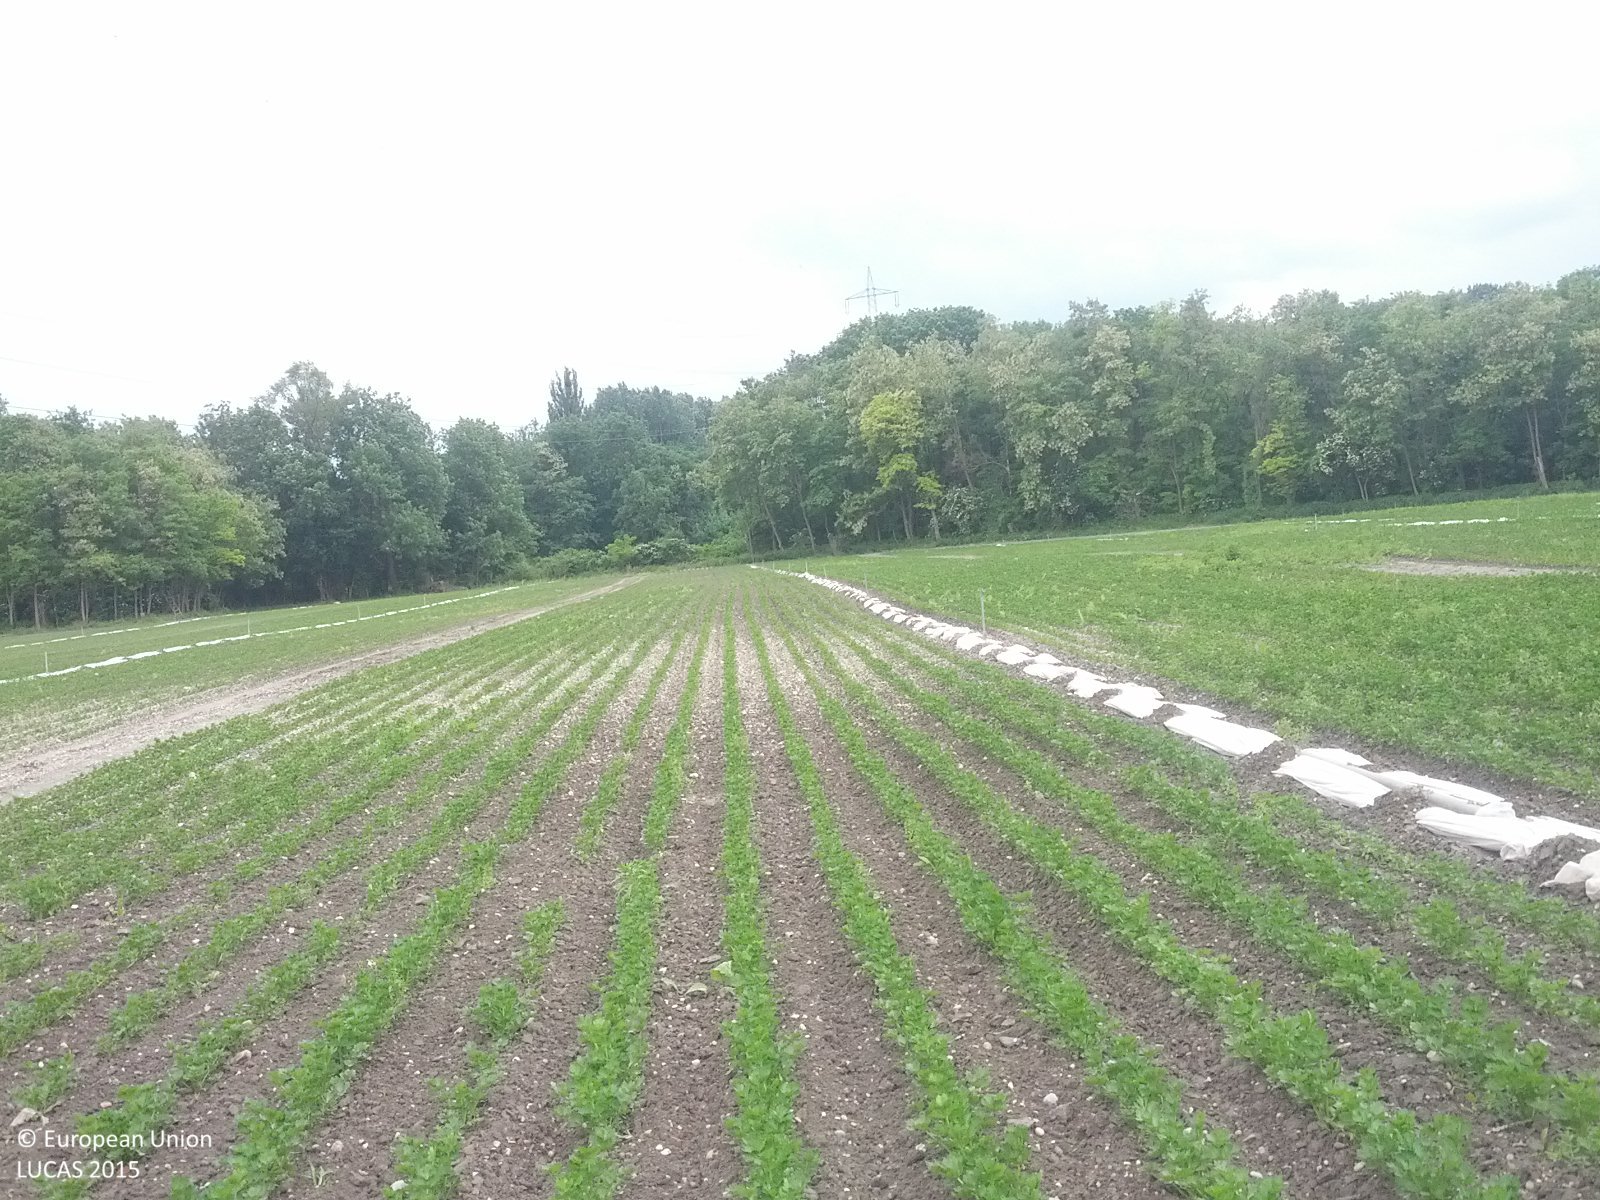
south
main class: Cropland
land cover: Other fresh vegetables
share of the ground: 25 - 50 %
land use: Agriculture (excluding fallow land and kitchen gardens)
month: May
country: AT
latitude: 48.1940
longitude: 16.5033
